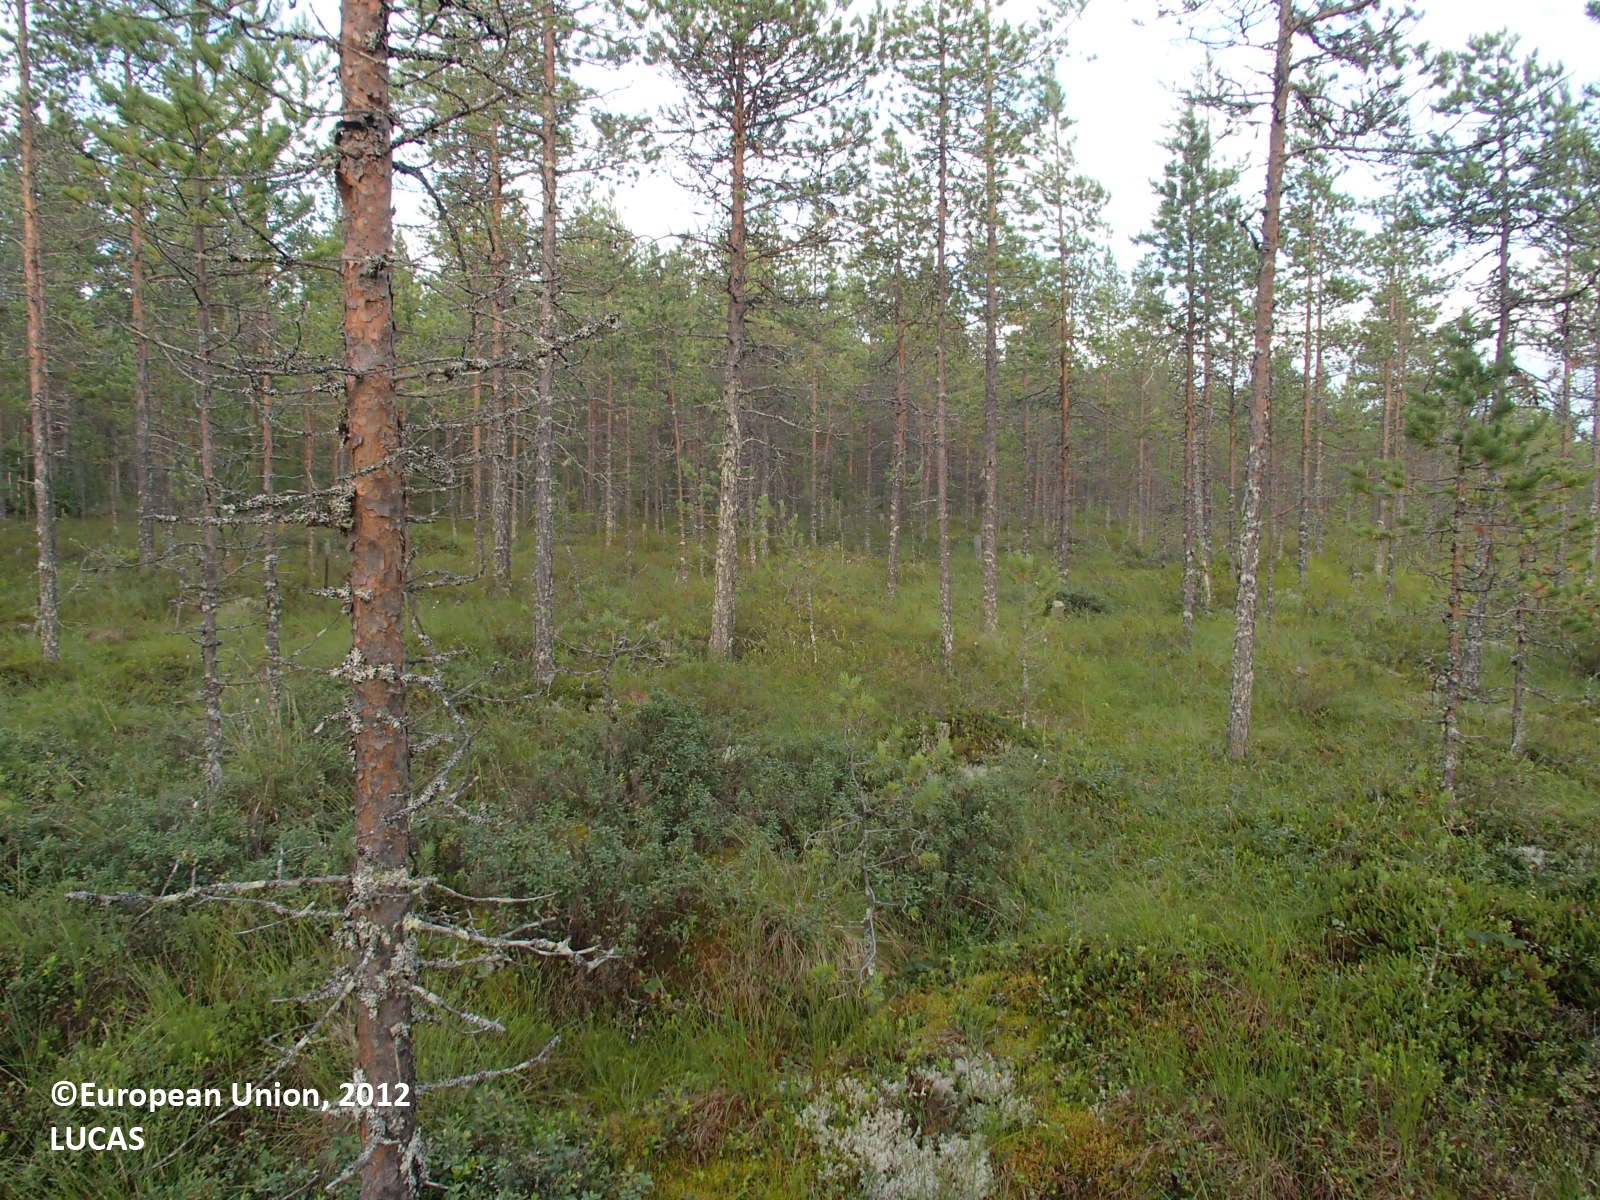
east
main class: Woodland
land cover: Pine dominated coniferous woodland
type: boreal forest
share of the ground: 10 - 25 %
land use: Forestry
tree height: > 5 m
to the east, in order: Pine dominated coniferous woodland; Ditches and canals; Pine dominated coniferous woodland; Ditches and canals; Pine dominated mixed woodland; Broadleaved woodland; Pine dominated mixed woodland
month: August
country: FI
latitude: 64.1011
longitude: 26.1361
